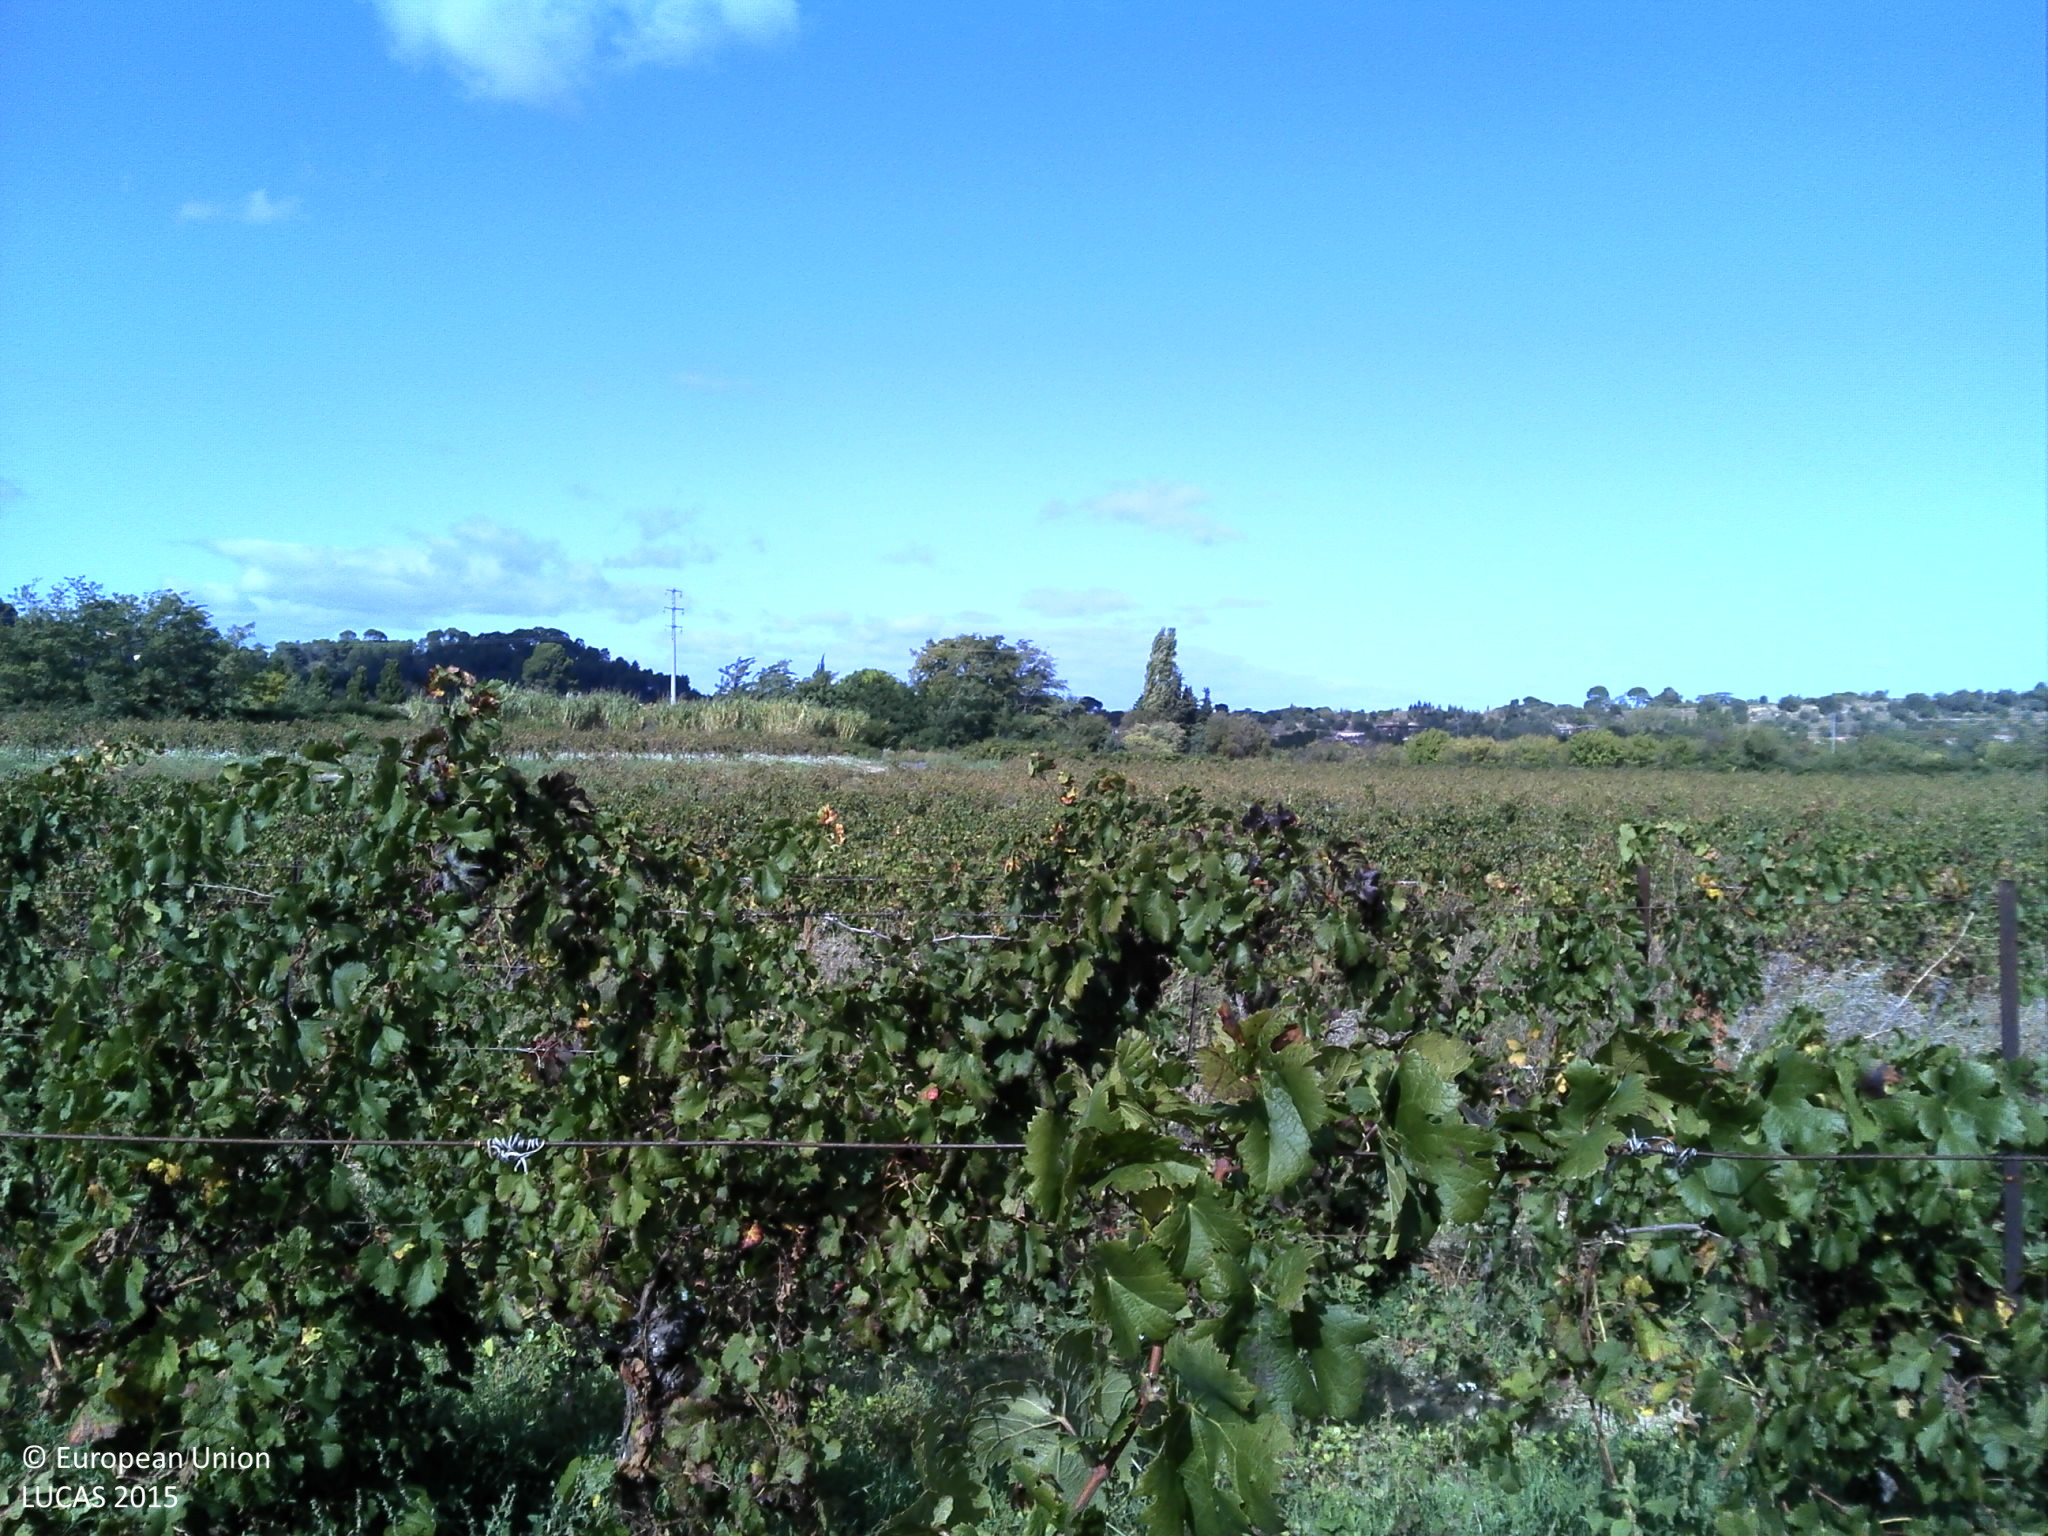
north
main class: Cropland
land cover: Vineyards
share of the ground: 10 - 25 %
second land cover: Spontaneously vegetated surfaces
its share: > 75 %
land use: Agriculture (excluding fallow land and kitchen gardens)
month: October
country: FR
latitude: 43.4526
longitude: 3.3978
